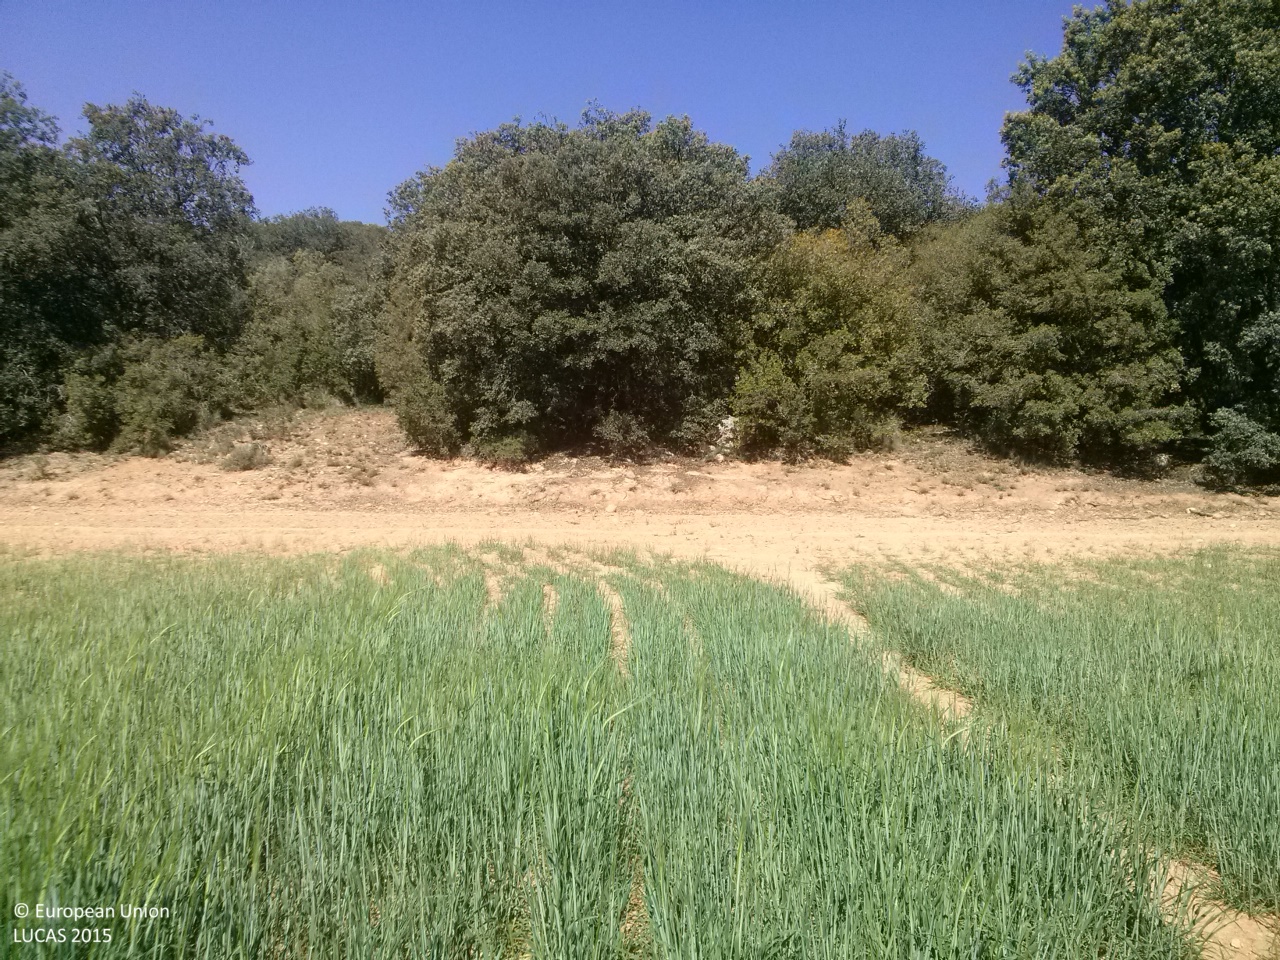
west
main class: Cropland
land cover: Barley
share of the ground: > 75 %
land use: Agriculture (excluding fallow land and kitchen gardens)
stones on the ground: 10 - 25 %
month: May
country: ES
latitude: 39.8616
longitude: -2.8201
